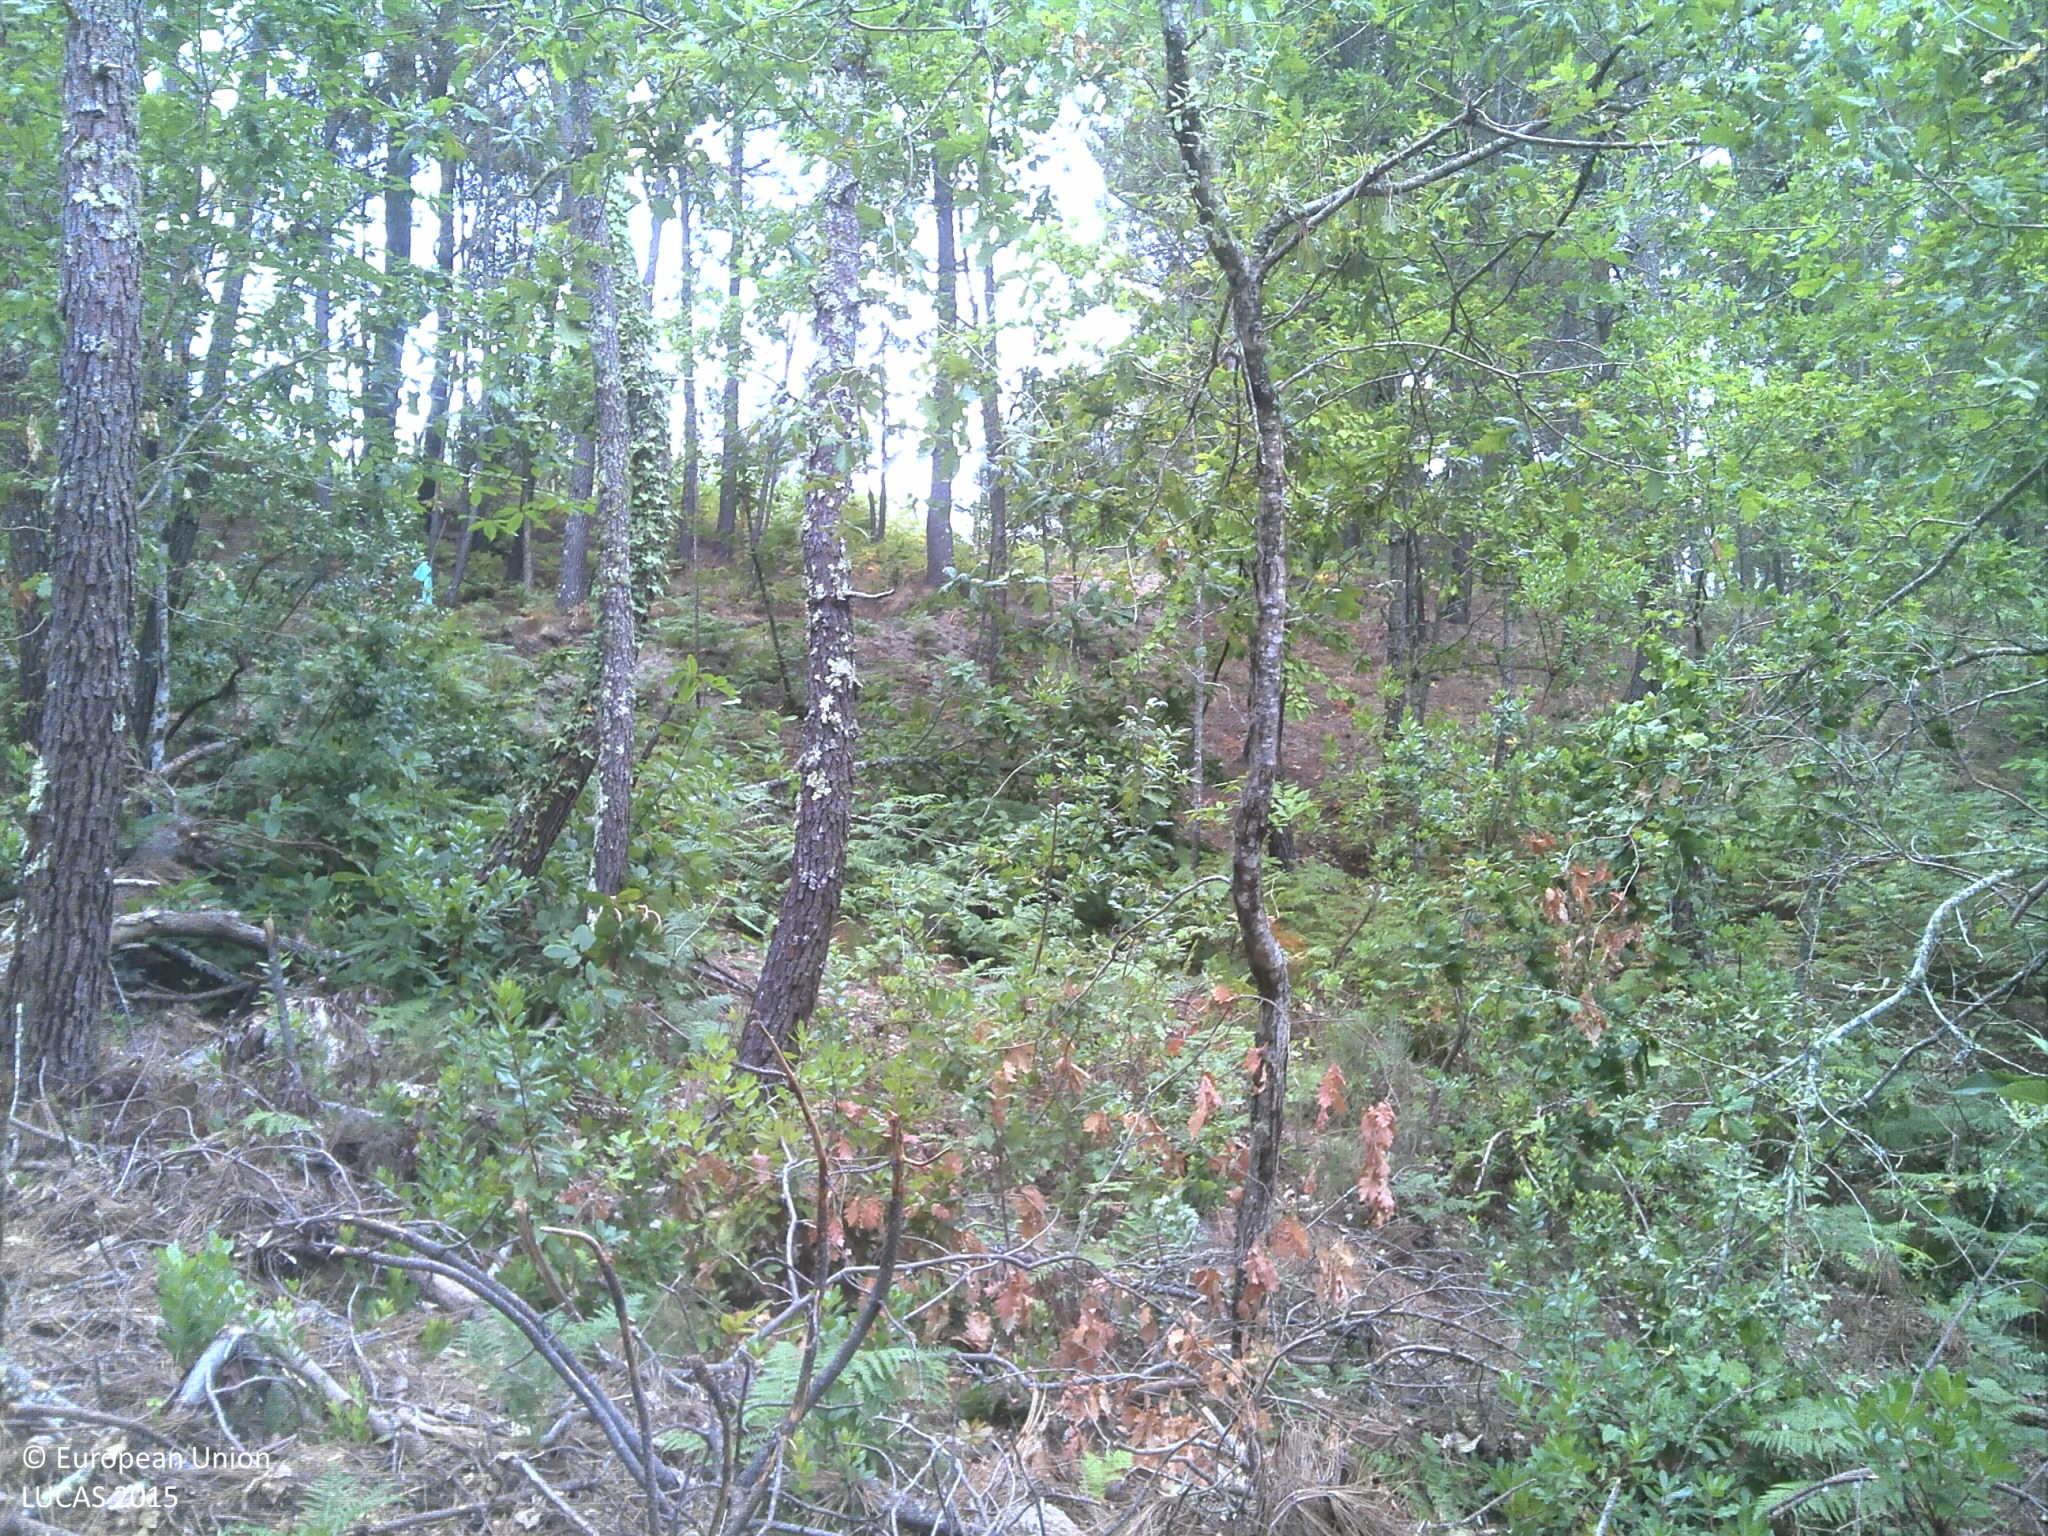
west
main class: Woodland
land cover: Broadleaved woodland
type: thermophilous deciduous forest
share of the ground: 25 - 50 %
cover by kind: broadleaved forest trees 40 %, unconsolidated bare surface 30 %, shrubs 20 %, herbaceous plants 10 %
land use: Forestry
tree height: > 5 m
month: July
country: PT
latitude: 40.3449
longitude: -7.7865
